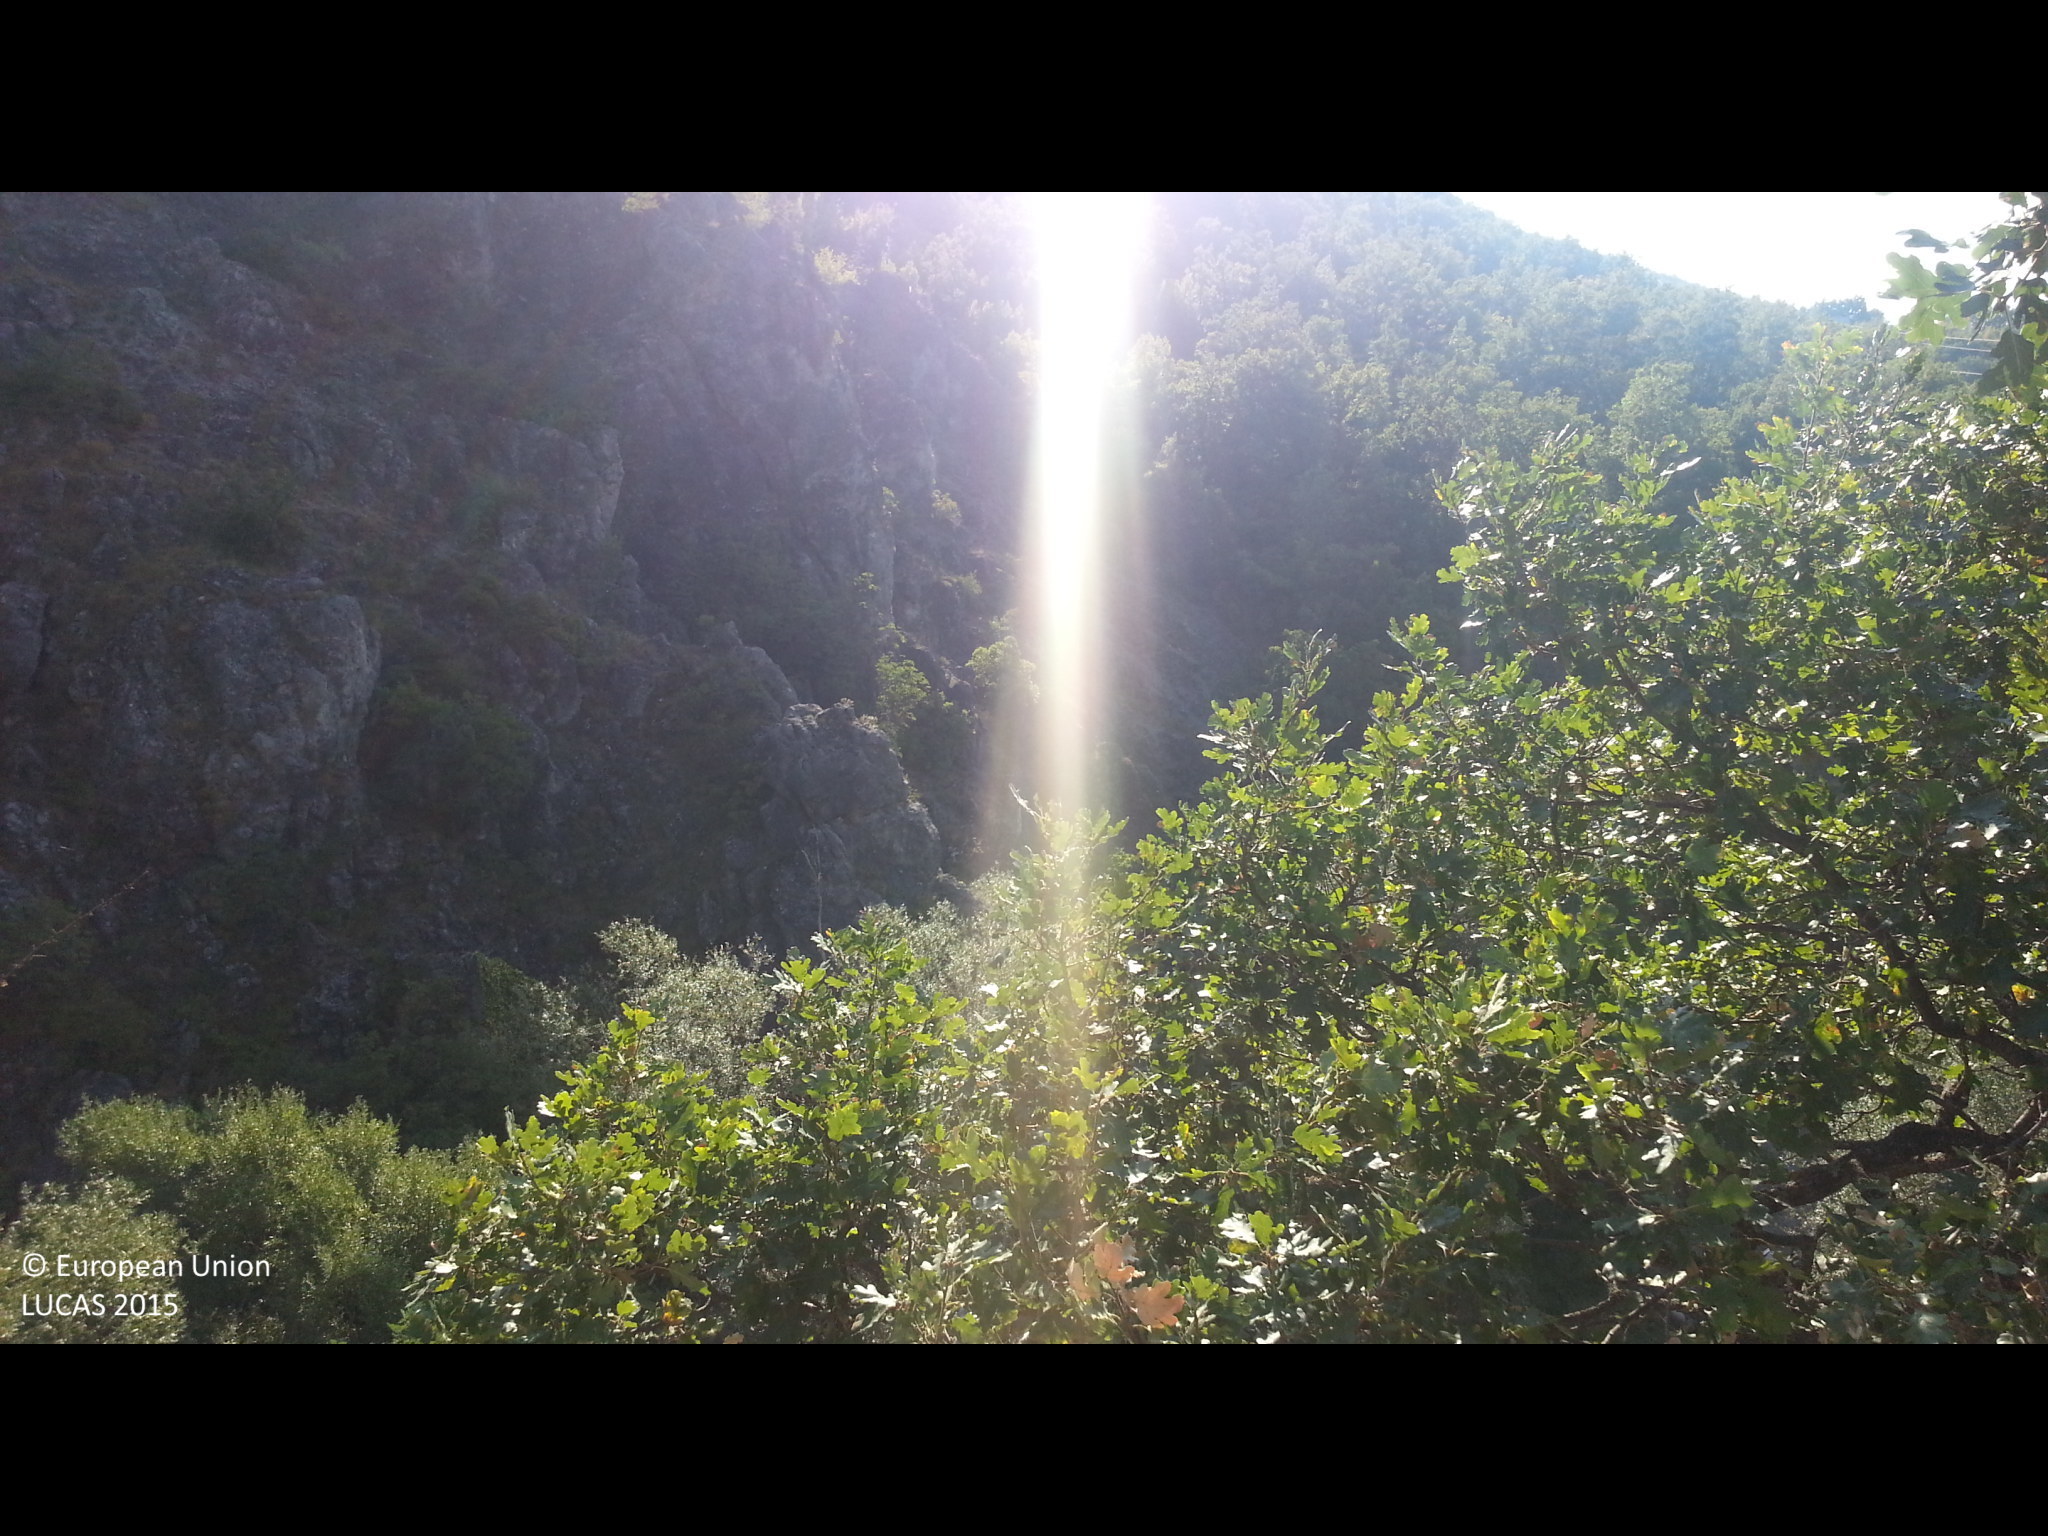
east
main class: Shrubland
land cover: Shrubland with sparse tree cover
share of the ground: 50 - 75 %
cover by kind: shrubs 55 %, consolidated bare surface 40 %, broadleaved forest trees 5 %
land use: Semi-natural and natural areas not in use
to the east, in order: Shrubland with sparse tree cover; Rocks and stones; Broadleaved woodland; Rocks and stones; Broadleaved woodland
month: September
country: BG
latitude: 42.3364
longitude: 22.9022
